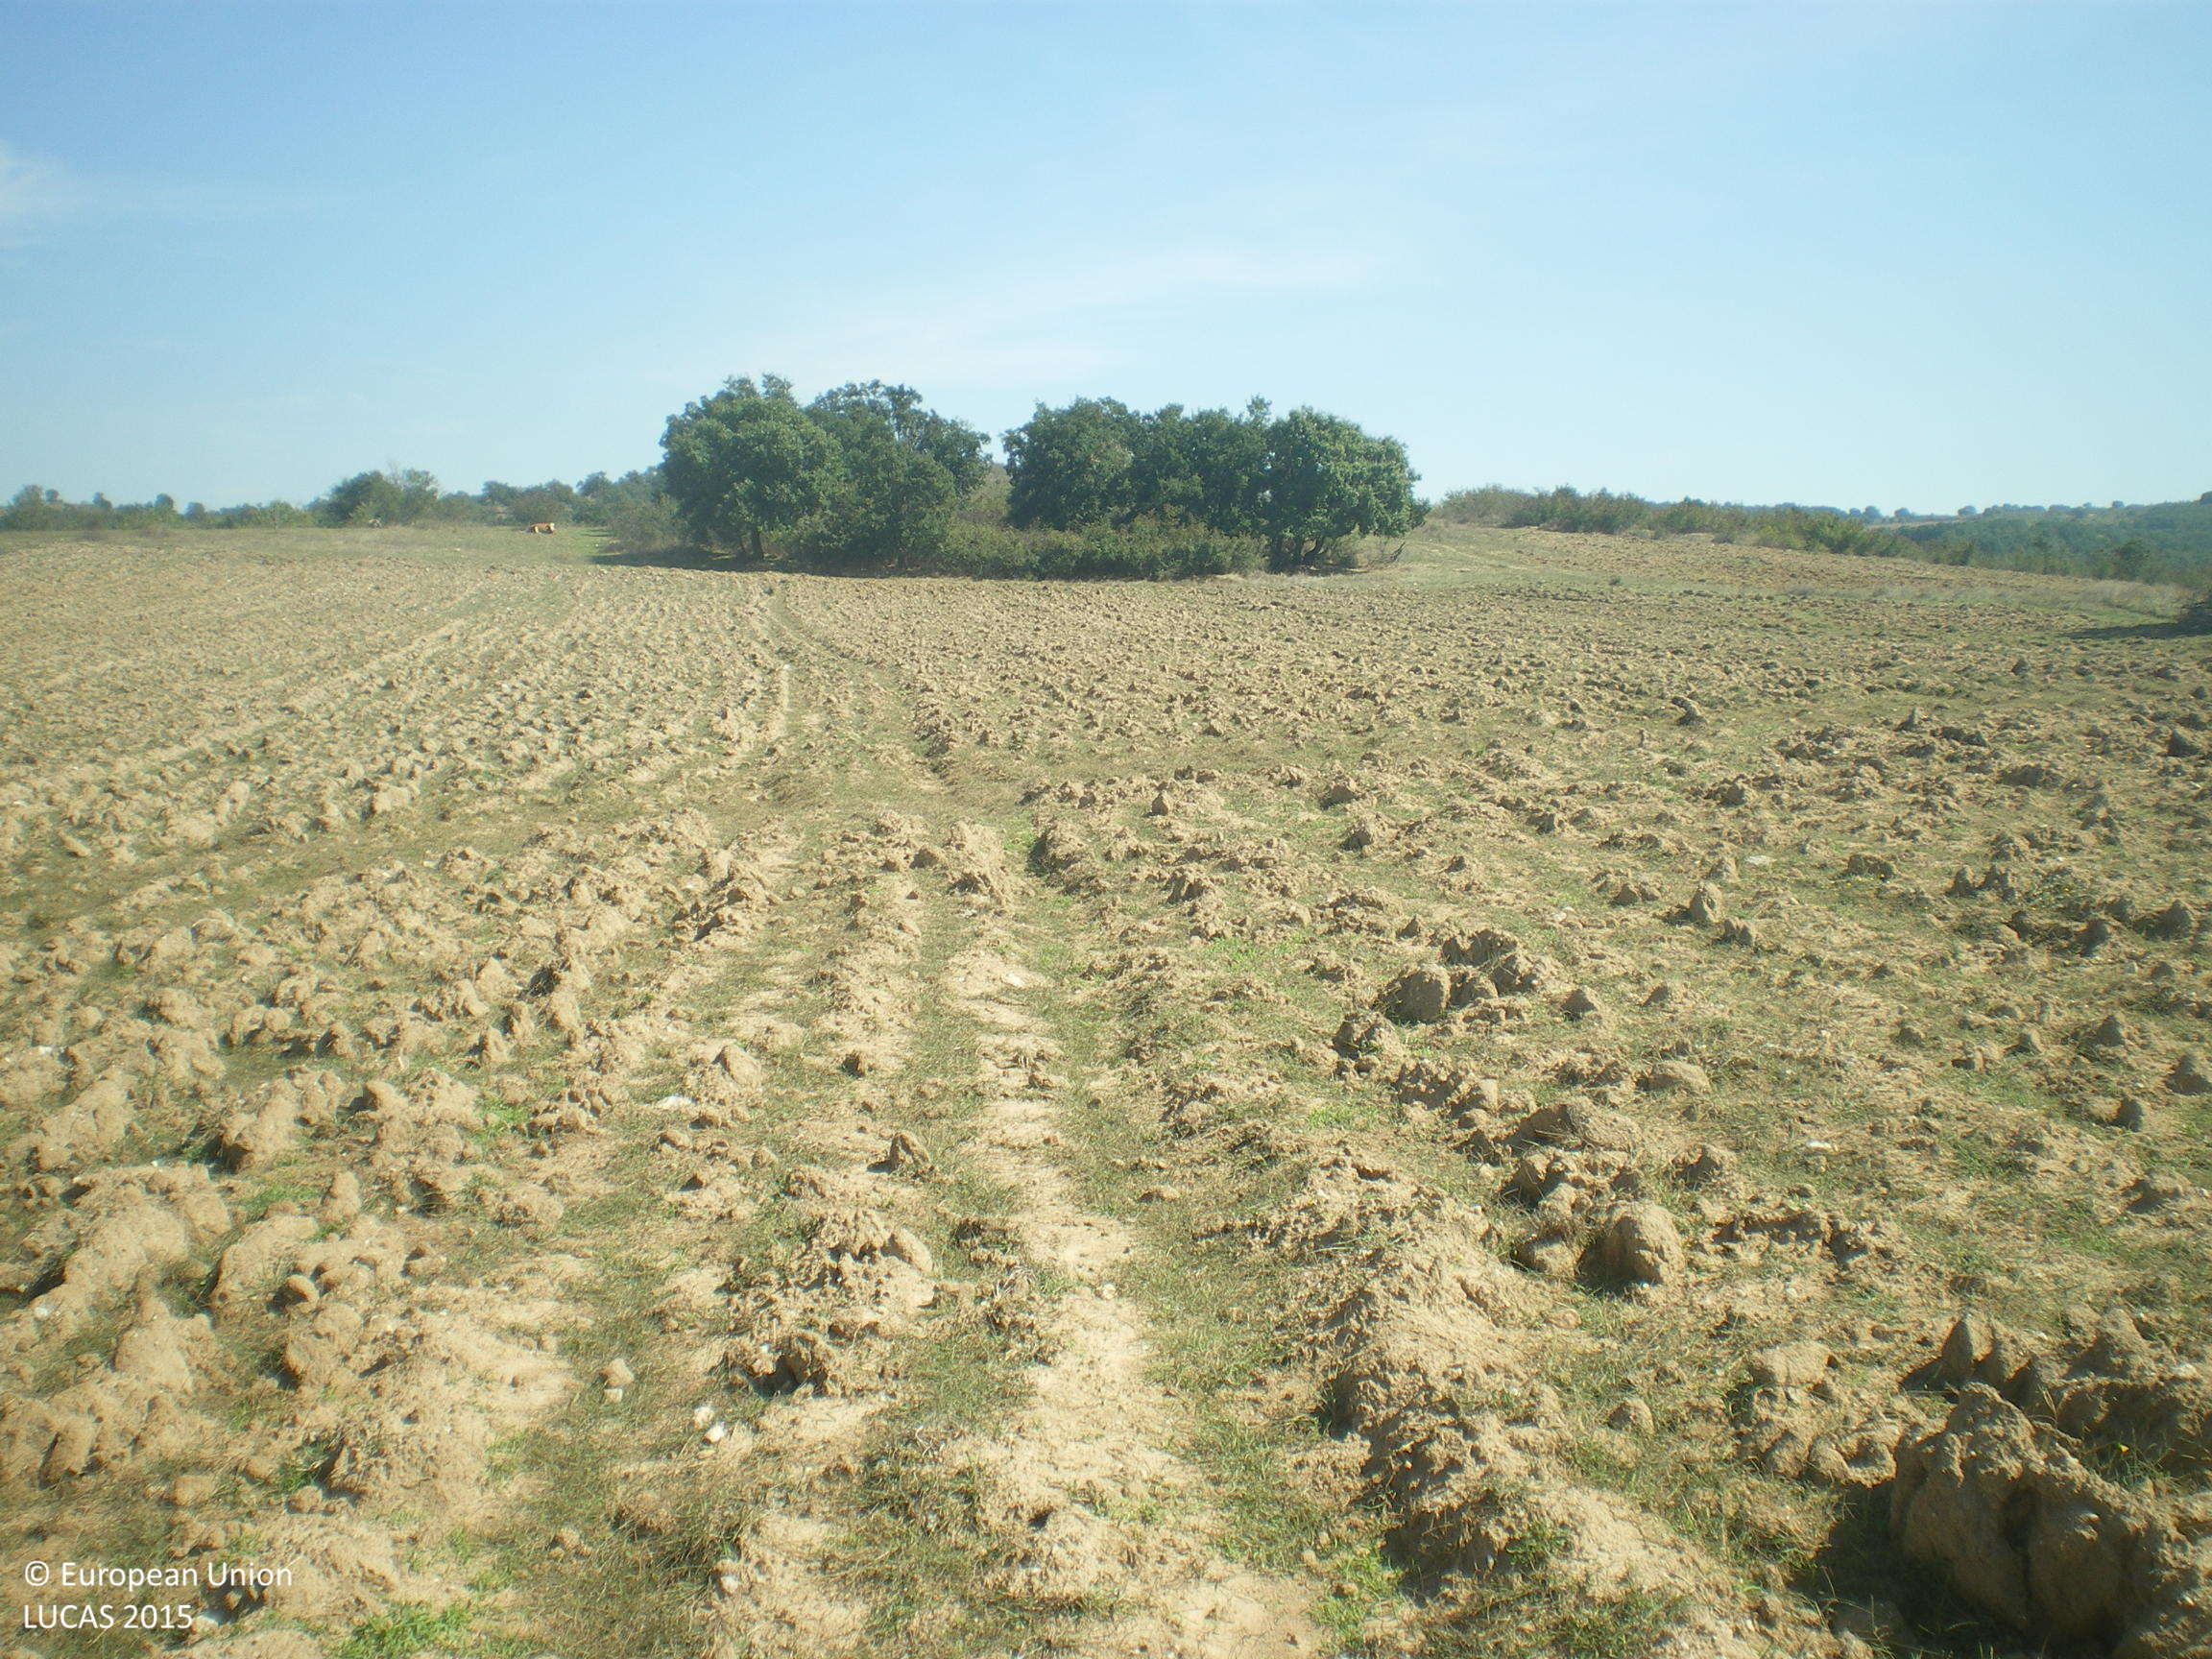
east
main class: Grassland
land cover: Spontaneously vegetated surfaces
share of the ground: 25 - 50 %
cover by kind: herbaceous plants 80 %, consolidated bare surface 20 %
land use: Agriculture (excluding fallow land and kitchen gardens)
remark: Harvested field
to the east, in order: Spontaneously vegetated surfaces; Broadleaved woodland; Grassland without tree/shrub cover
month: September
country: BG
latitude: 41.8944
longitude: 25.7239
